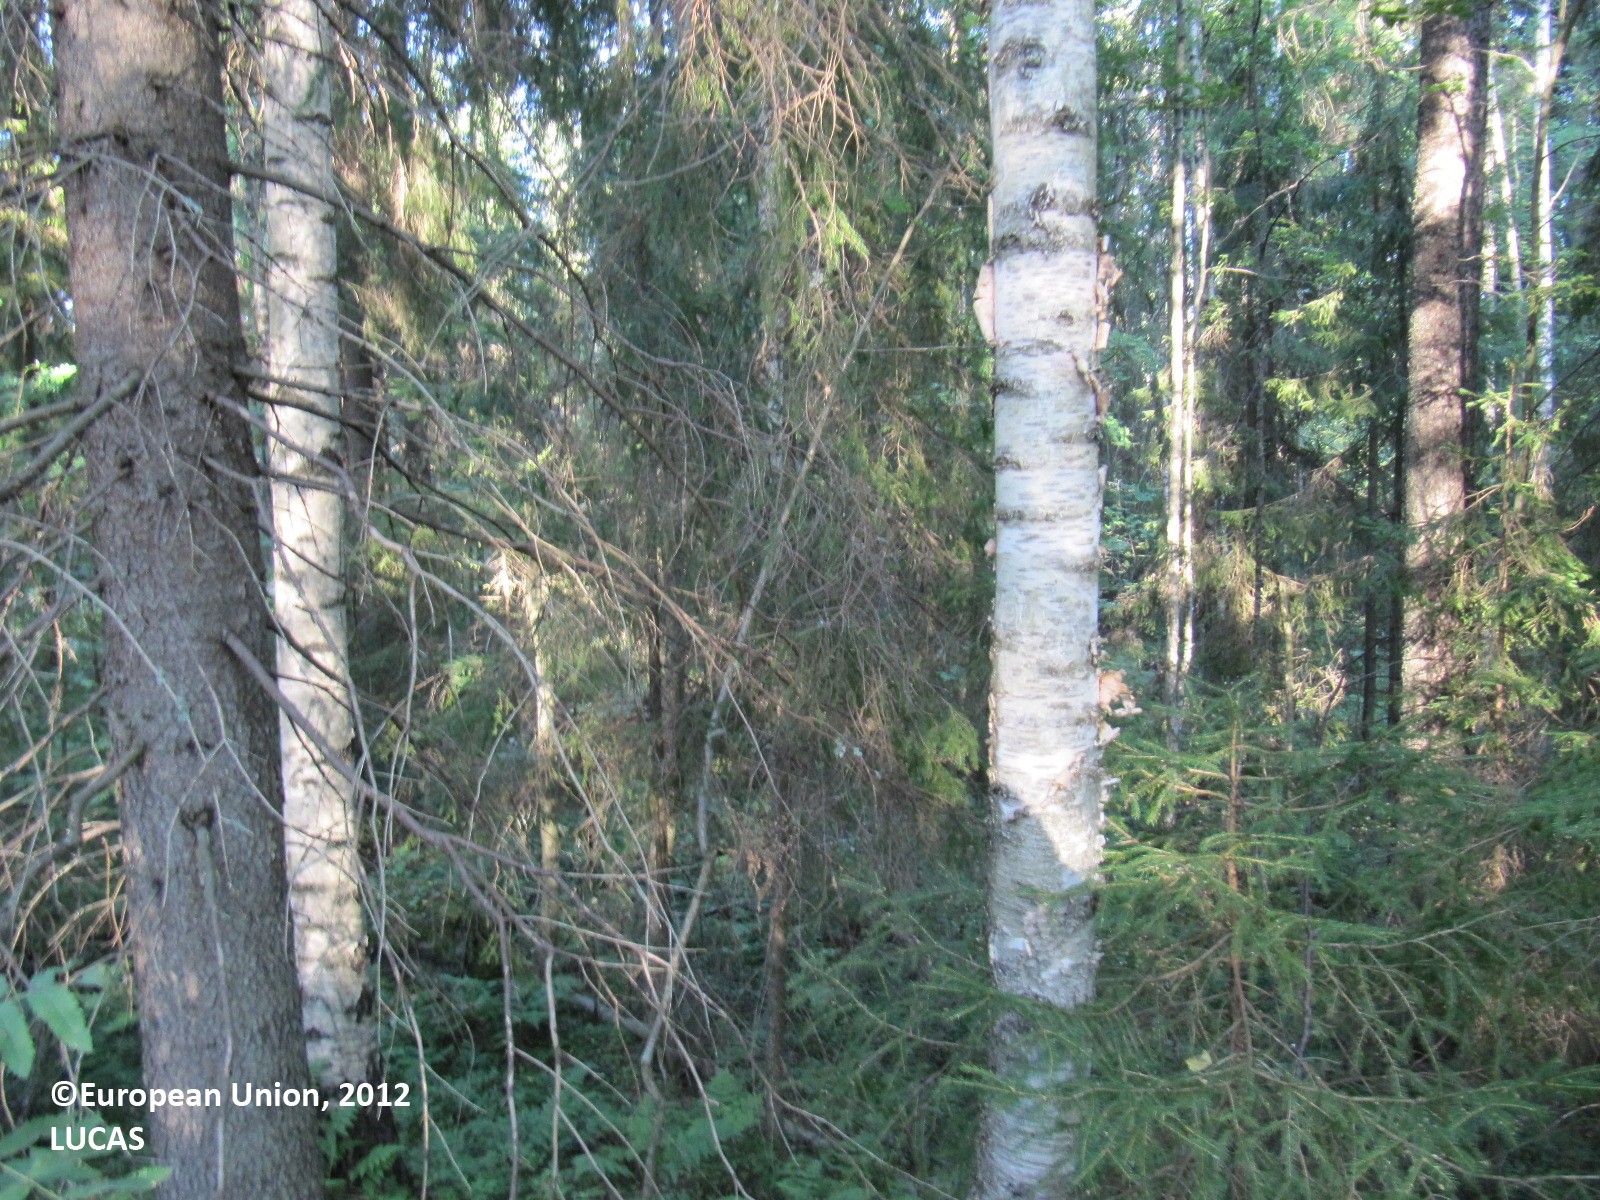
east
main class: Woodland
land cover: Spruce dominated mixed woodland
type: boreal forest
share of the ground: > 75 %
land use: Forestry
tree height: > 5 m
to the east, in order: Spruce dominated mixed woodland; Paved roads, cycling and walking lanes; Electric lines; Spruce dominated mixed woodland; Tracks; Spruce dominated mixed woodland; Tracks; Electric lines; Spruce dominated mixed woodland; Artificial constructions in urban areas
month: August
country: FI
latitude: 60.5426
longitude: 24.5261
